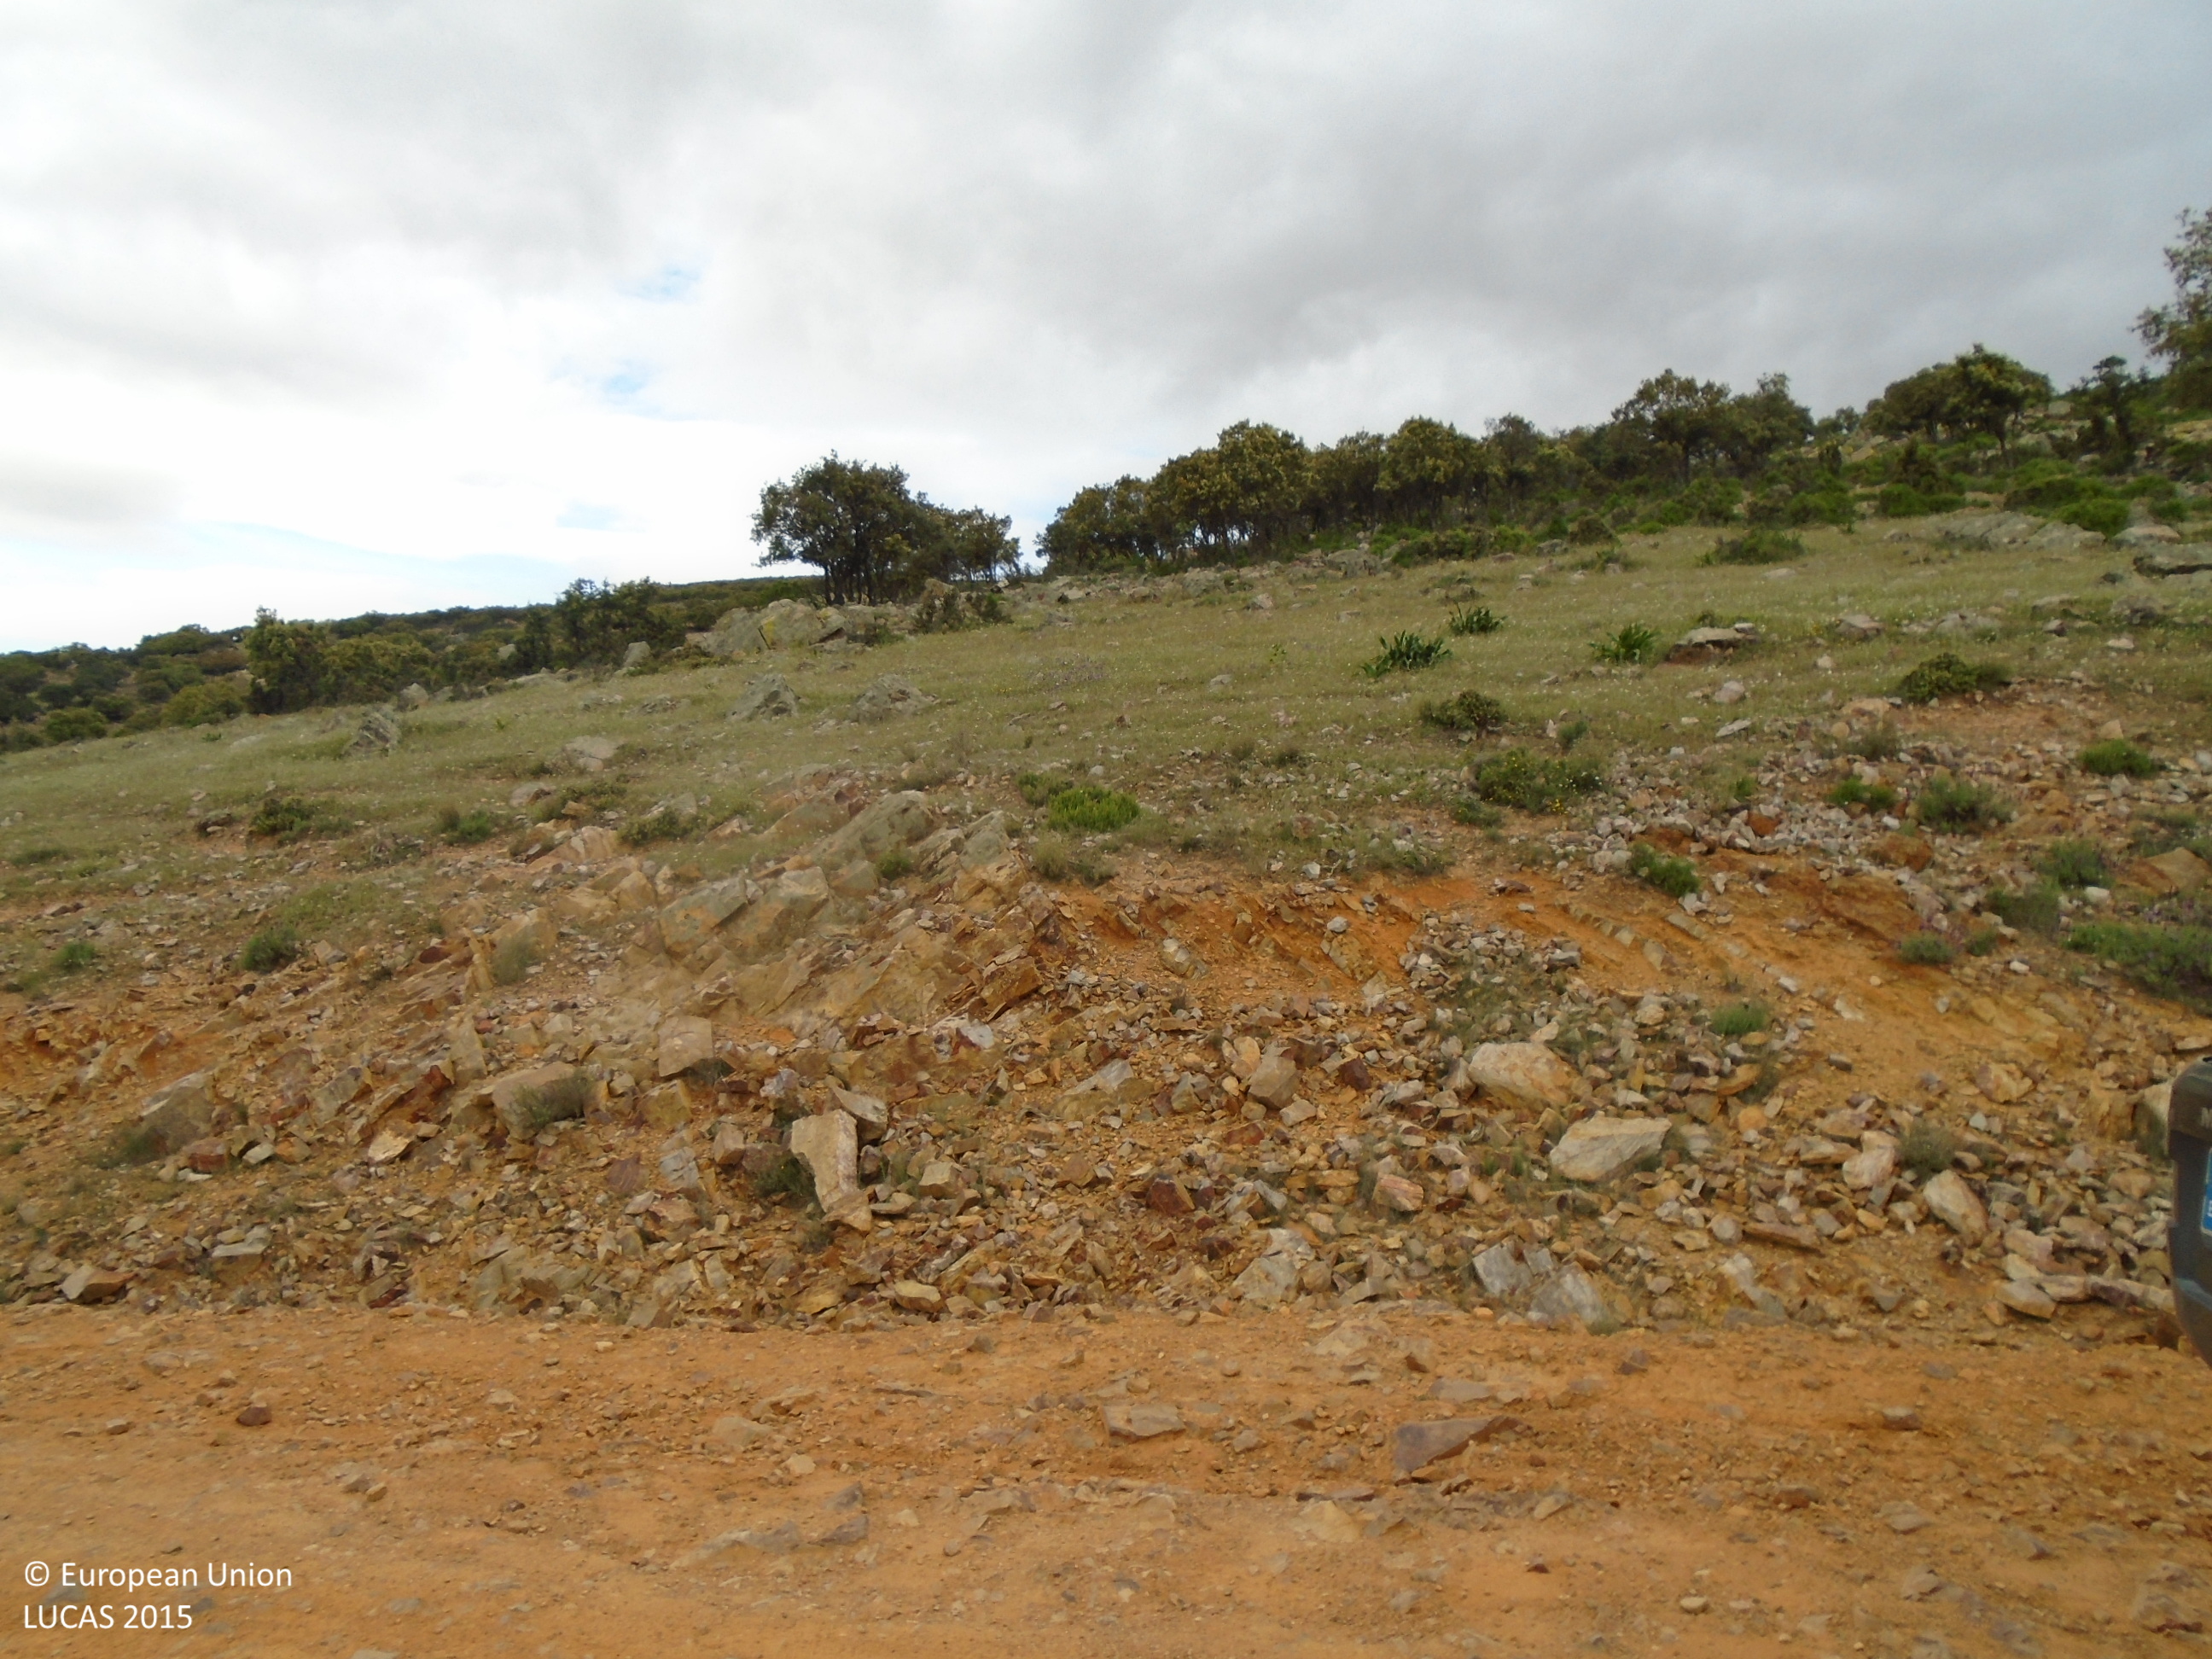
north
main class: Grassland
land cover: Grassland with sparse tree/shrub cover
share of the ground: > 75 %
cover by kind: herbaceous plants 85 %, broadleaved forest trees 5 %, shrubs 5 %, consolidated bare surface 5 %
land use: Semi-natural and natural areas not in use
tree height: < 5 m
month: May
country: ES
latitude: 39.6609
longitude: -4.6215
